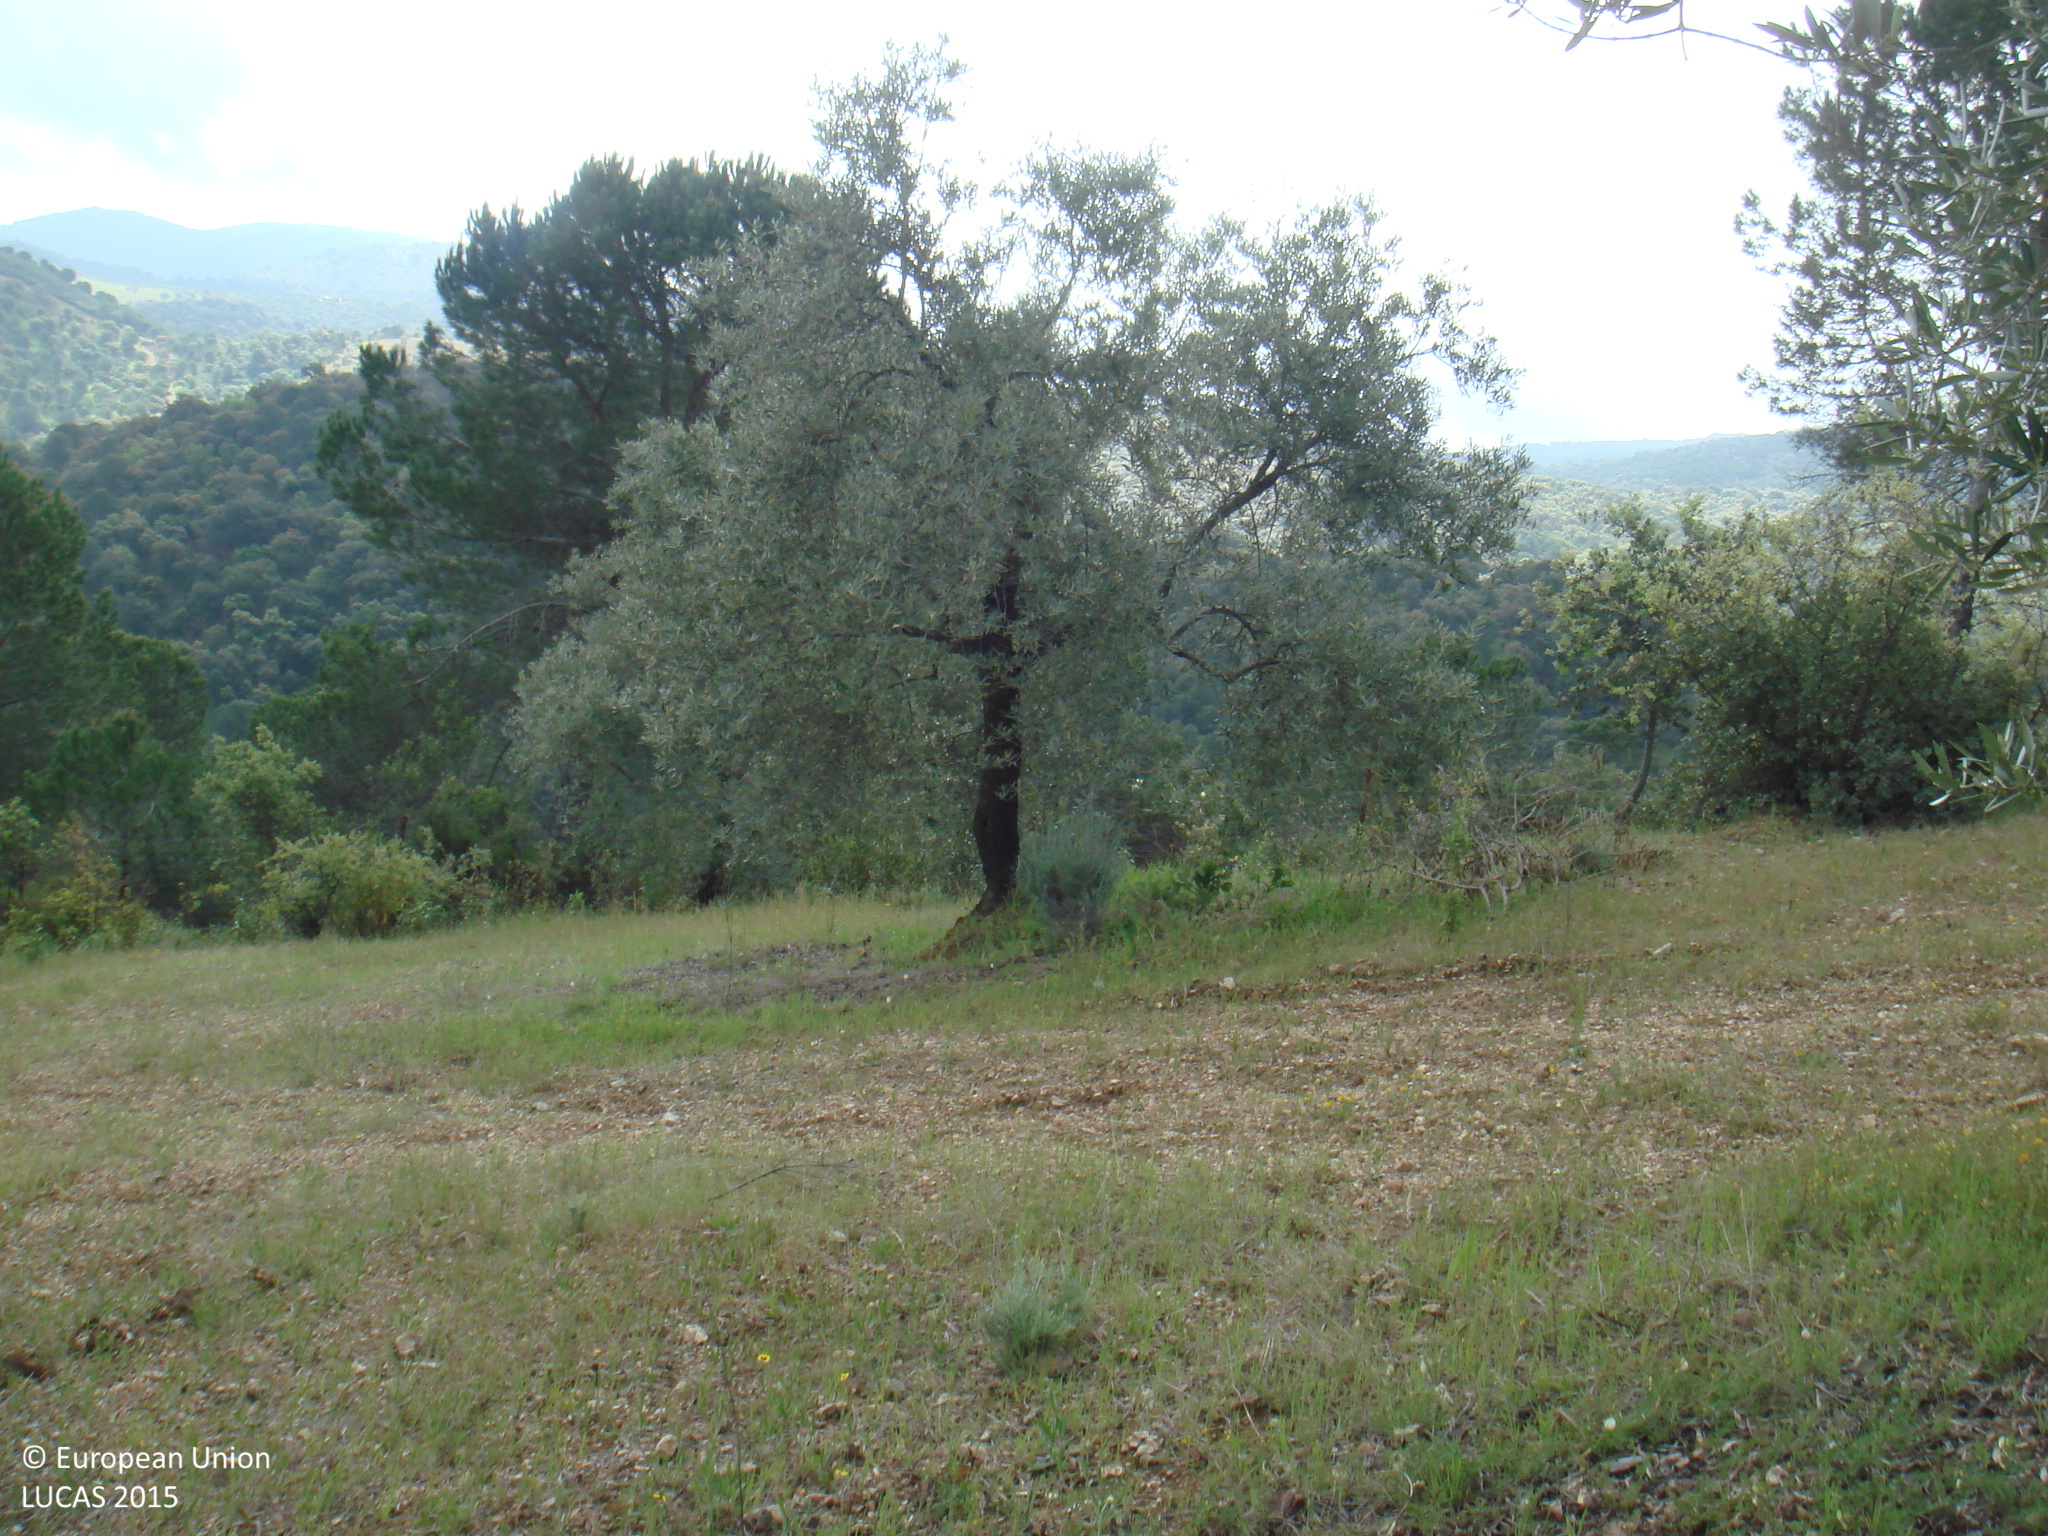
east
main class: Cropland
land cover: Olive groves
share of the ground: 10 - 25 %
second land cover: Spontaneously vegetated surfaces
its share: > 75 %
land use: Agriculture (excluding fallow land and kitchen gardens)
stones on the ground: 10 - 25 %
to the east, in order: Olive groves; Spontaneously vegetated surfaces; Fences; Pine dominated coniferous woodland; Tracks; Pine dominated coniferous woodland
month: April
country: ES
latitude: 38.0793
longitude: -4.9891
